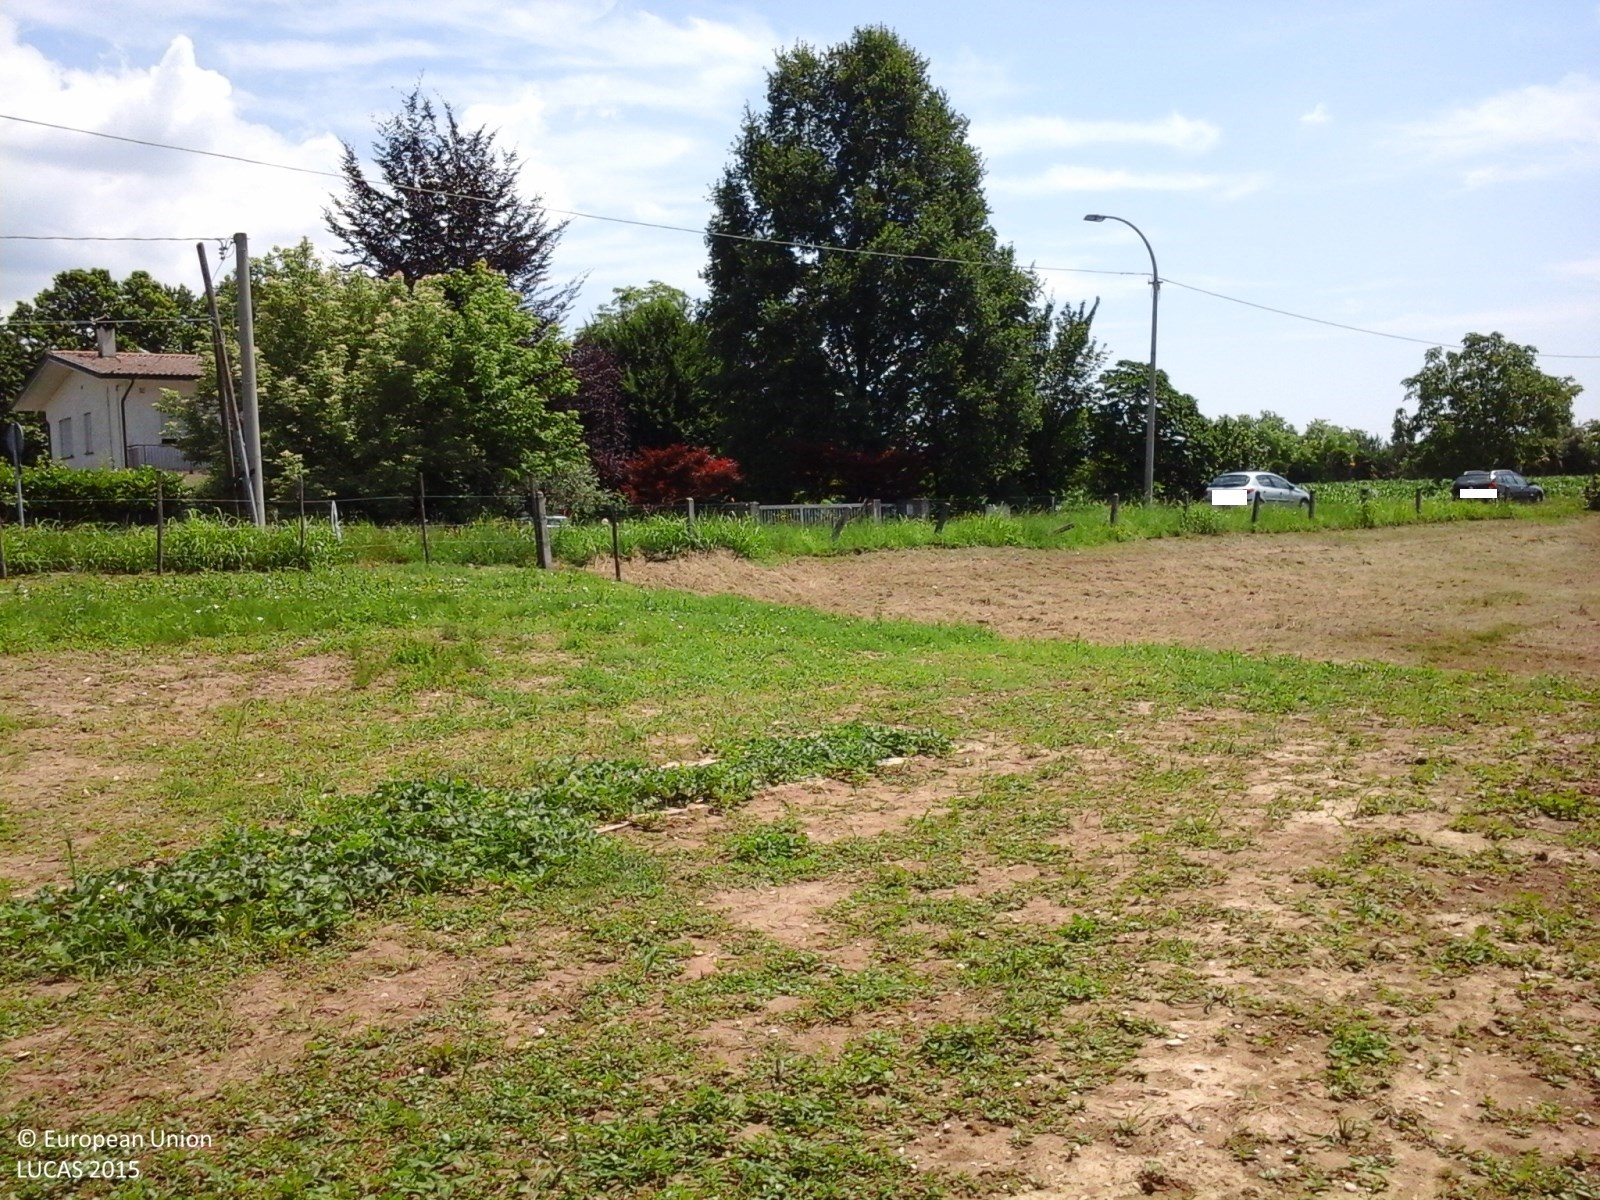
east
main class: Grassland
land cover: Spontaneously vegetated surfaces
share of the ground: > 75 %
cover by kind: herbaceous plants 50 %, consolidated bare surface 50 %
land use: Fallow land
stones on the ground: 10 - 25 %
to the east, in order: Spontaneously vegetated surfaces; Other bare soil; Fences; Electric lines; Grass margins; Paved roads, cycling and walking lanes; Ditches and canals; Electric lines; Fences; Broadleaved woodland; Fences; Maize; Electric lines; Maize; Nuts trees; Artificial constructions in urban areas
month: June
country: IT
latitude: 45.9648
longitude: 12.3584
